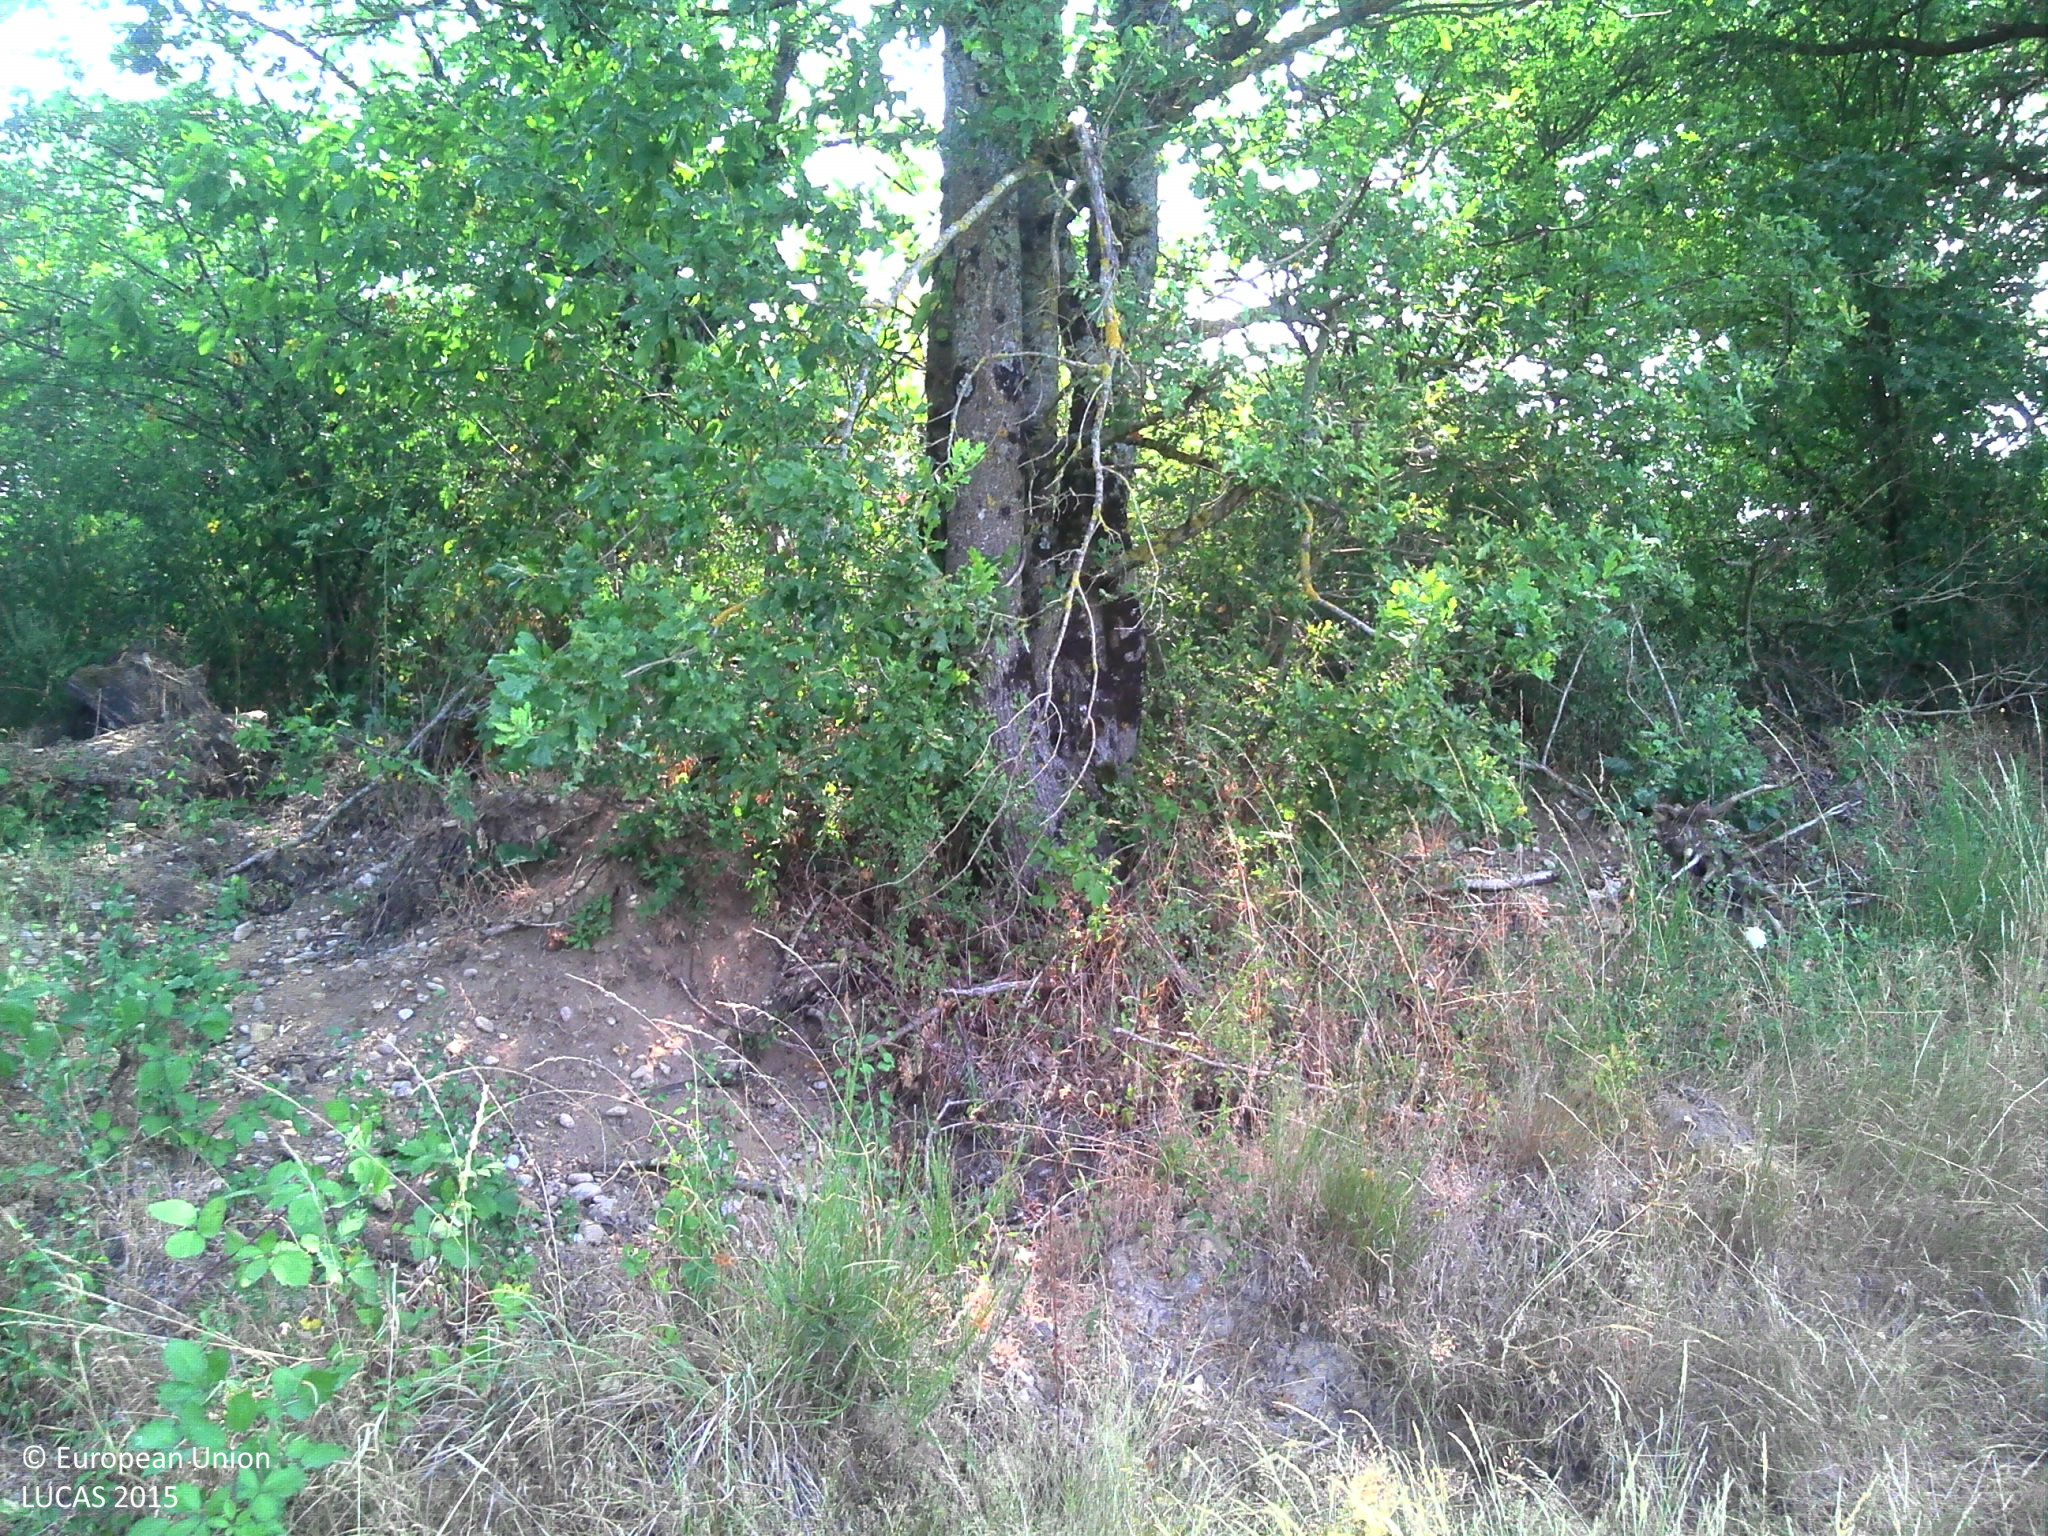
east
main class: Grassland
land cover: Grassland without tree/shrub cover
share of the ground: > 75 %
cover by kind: herbaceous plants 100 %
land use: Agriculture (excluding fallow land and kitchen gardens)
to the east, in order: Grassland without tree/shrub cover; Broadleaved woodland; Maize; Broadleaved woodland; Grass margins; Paved roads, cycling and walking lanes; Electric lines; Paved roads, cycling and walking lanes; Grass margins; Managed hedges; Fences; Grassland without tree/shrub cover
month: July
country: FR
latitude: 46.1382
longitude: 0.6261
